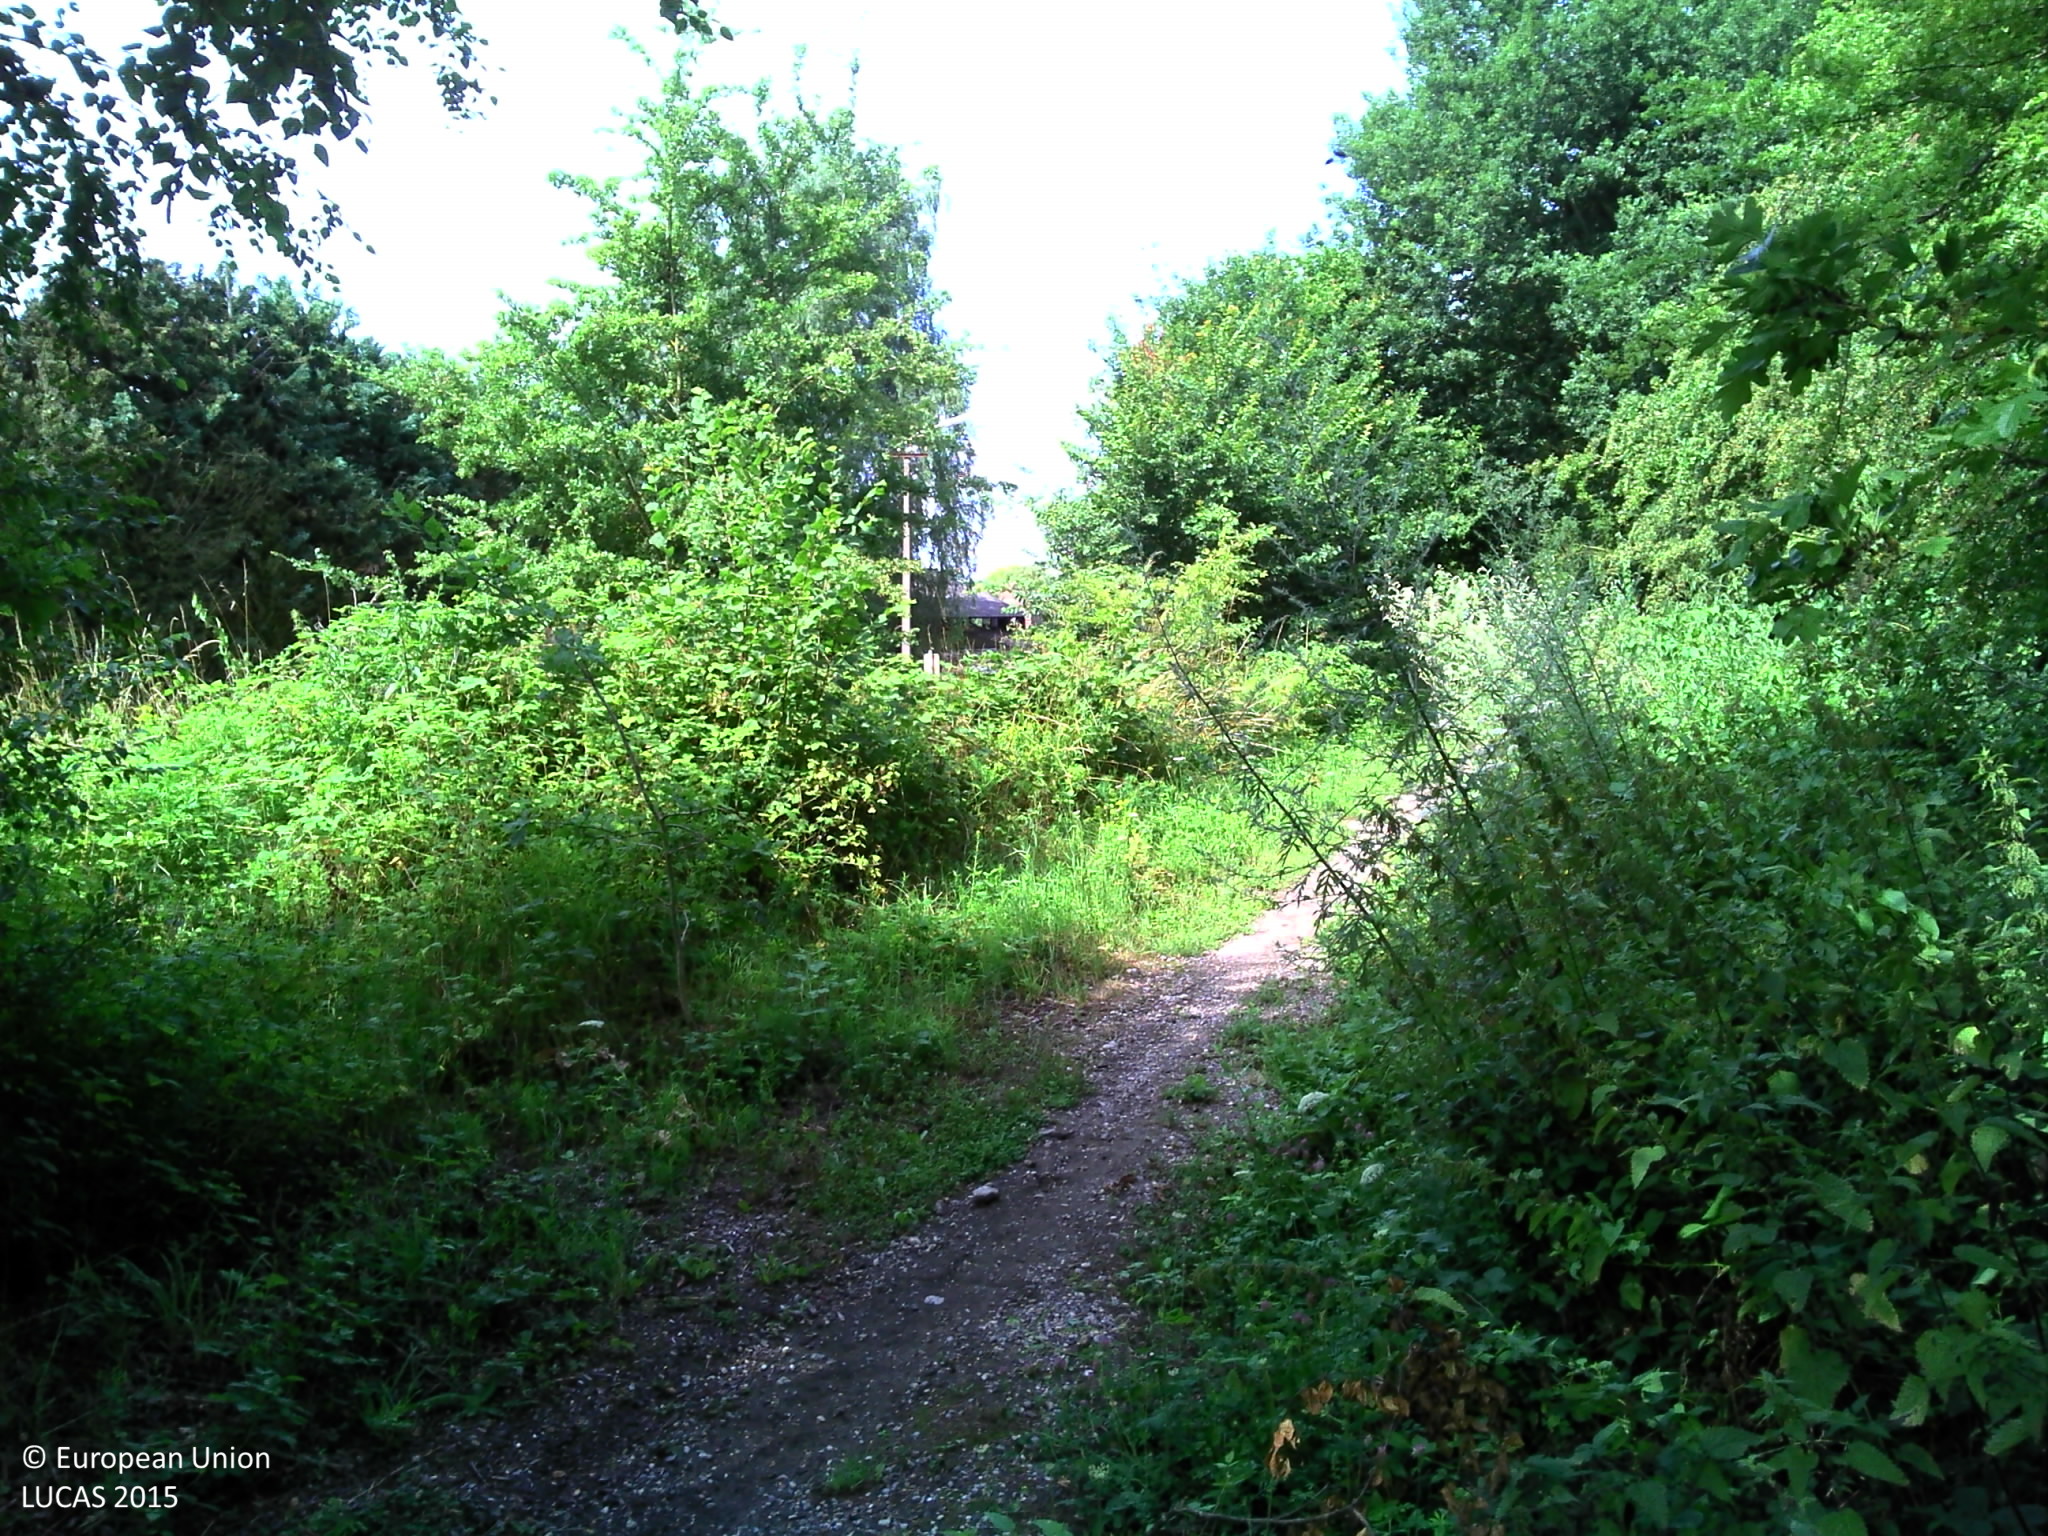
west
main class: Shrubland
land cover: Shrubland with sparse tree cover
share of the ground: > 75 %
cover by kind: shrubs 60 %, herbaceous plants 35 %, broadleaved forest trees 5 %
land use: Abandoned areas
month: July
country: BE
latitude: 50.5756
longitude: 4.1628
